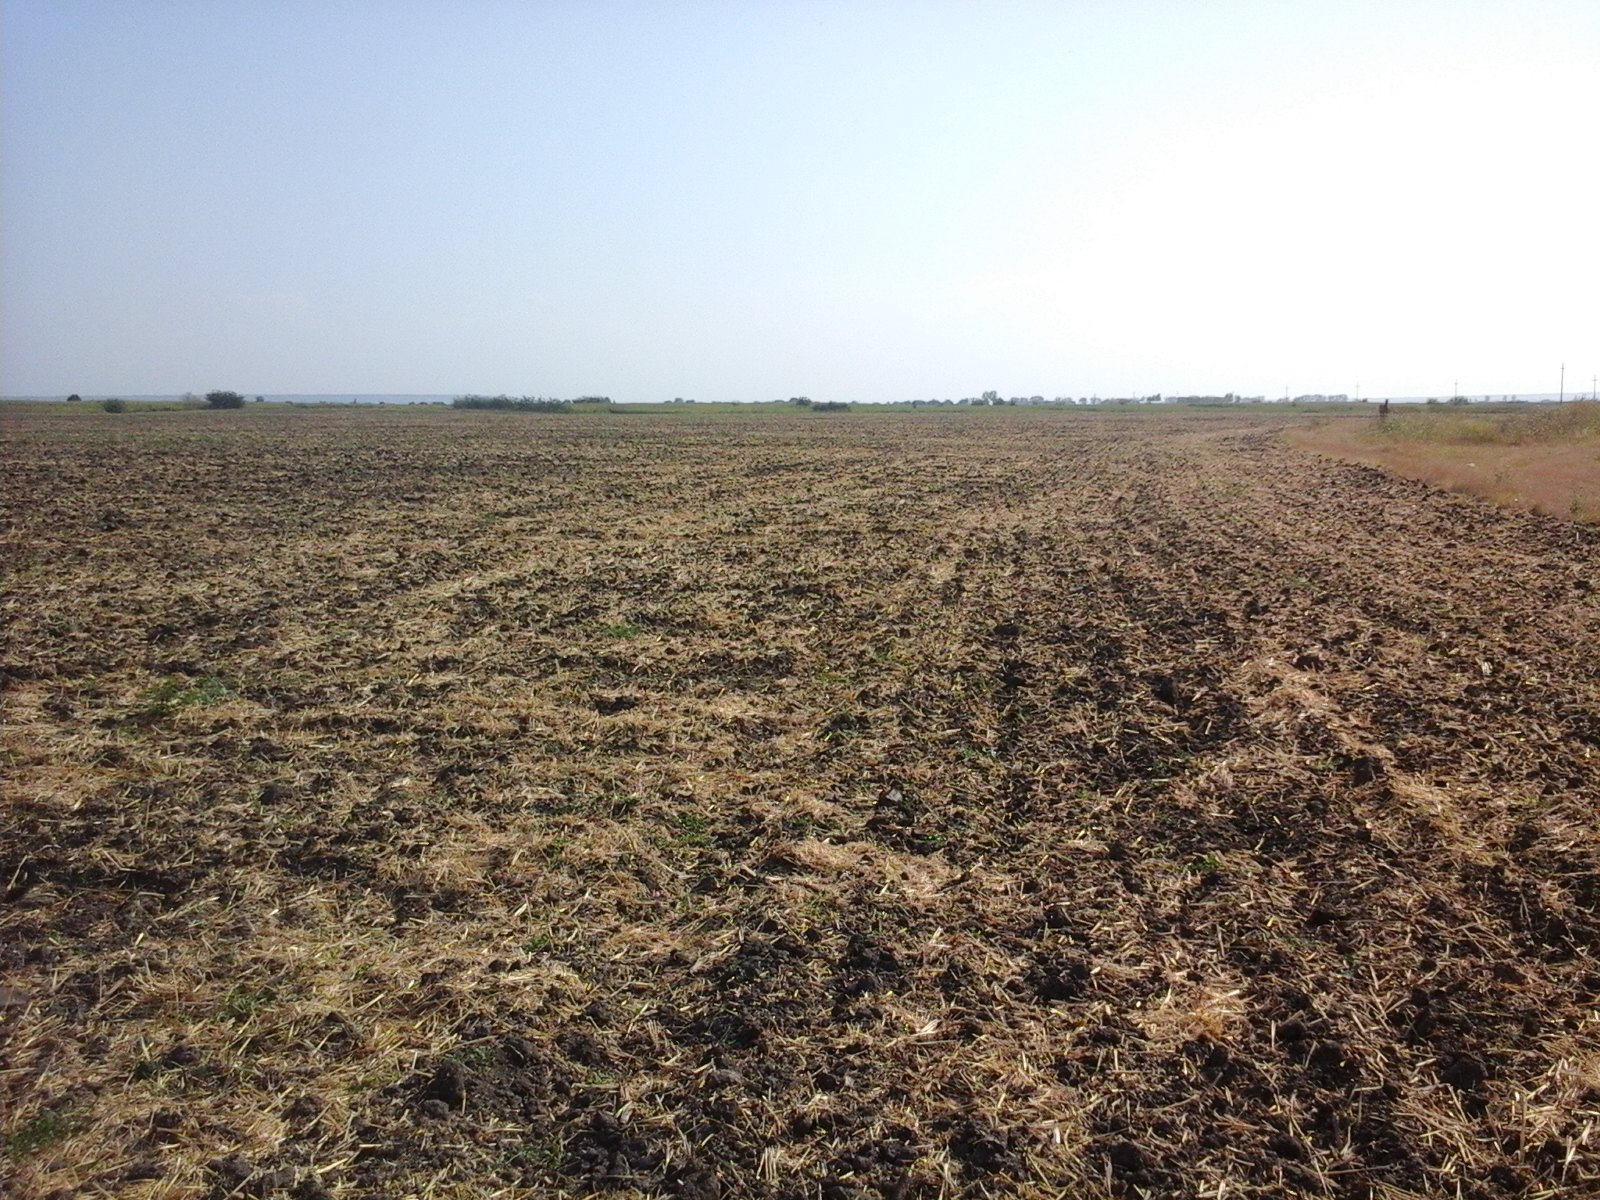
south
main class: Cropland
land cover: Common wheat
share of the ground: 10 - 25 %
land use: Agriculture (excluding fallow land and kitchen gardens)
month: August
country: RO
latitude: 43.9124
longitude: 23.5603
